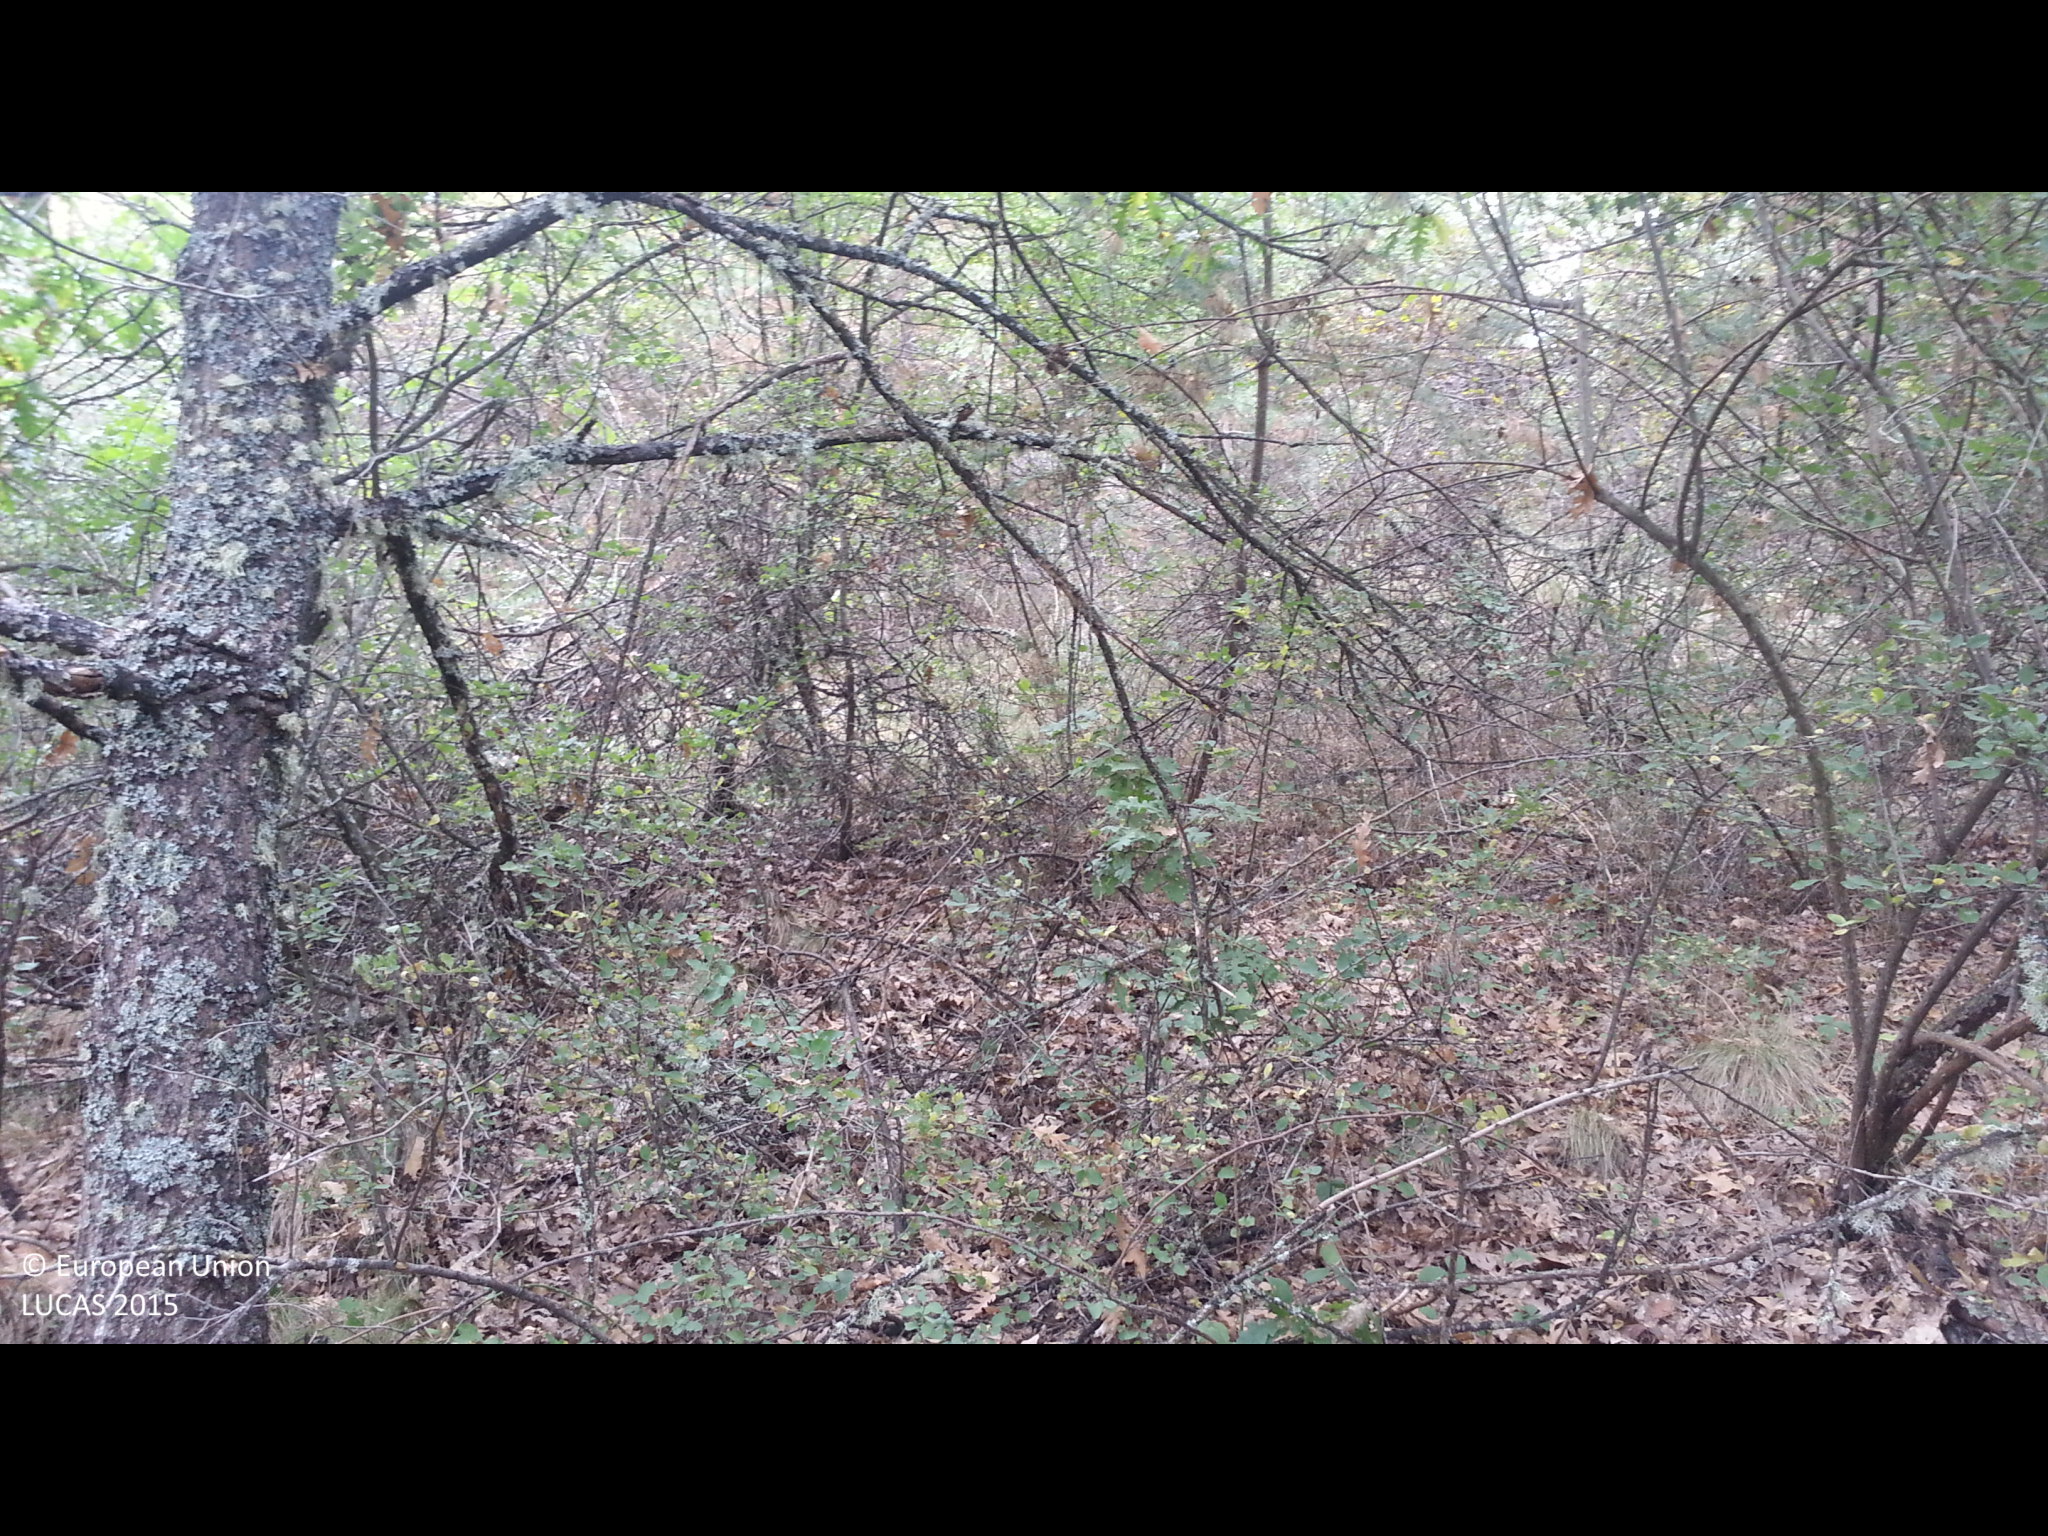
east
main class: Woodland
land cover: Broadleaved woodland
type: mesophytic deciduous forest
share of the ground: > 75 %
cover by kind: broadleaved forest trees 85 %, shrubs 10 %, coniferous forest trees 5 %
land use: Forestry
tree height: > 5 m
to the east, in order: Broadleaved woodland; Grassland with sparse tree/shrub cover; Other mixed woodland; Shrubland with sparse tree cover; Grassland with sparse tree/shrub cover; Tracks; Other mixed woodland; Ditches and canals; Other mixed woodland
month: September
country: BG
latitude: 42.3760
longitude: 22.5910
